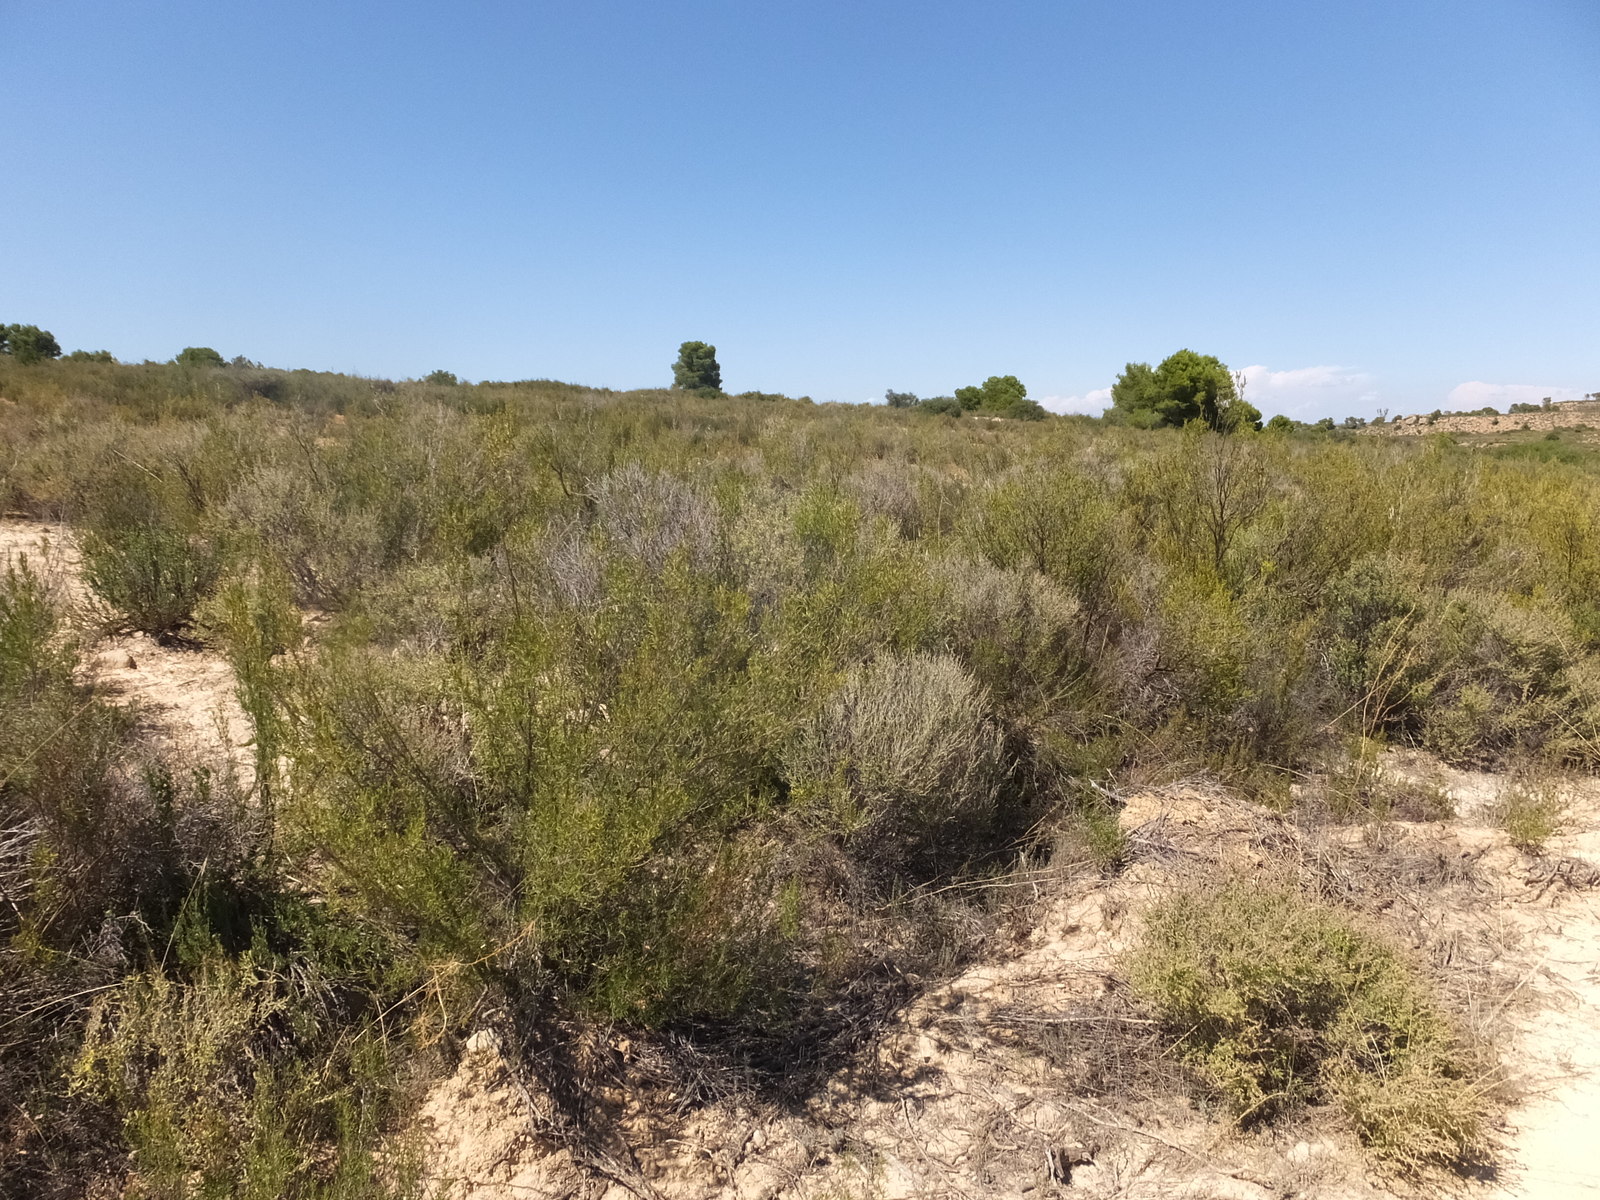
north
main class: Shrubland
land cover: Shrubland without tree cover
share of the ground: > 75 %
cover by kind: shrubs 80 %, herbaceous plants 10 %, consolidated bare surface 10 %
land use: Semi-natural and natural areas not in use
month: August
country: ES
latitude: 41.2399
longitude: 0.0967
